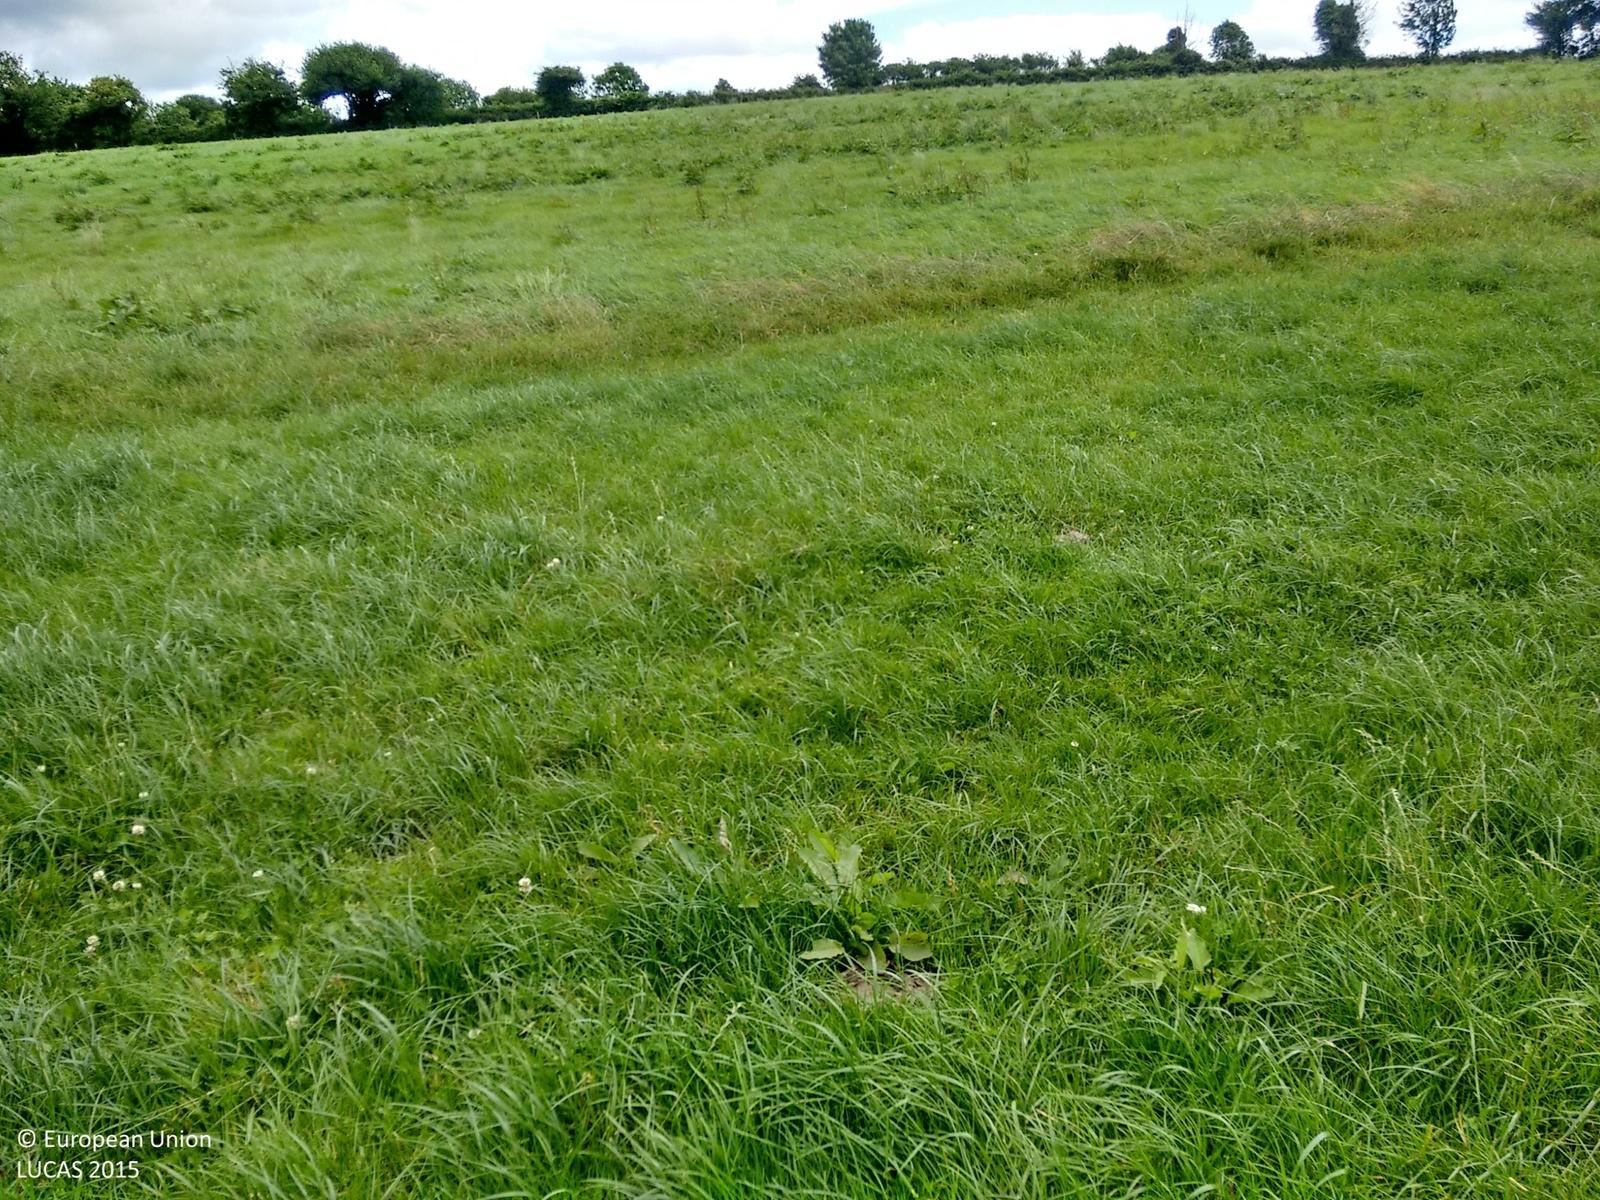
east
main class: Grassland
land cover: Grassland without tree/shrub cover
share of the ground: > 75 %
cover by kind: herbaceous plants 100 %
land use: Agriculture (excluding fallow land and kitchen gardens)
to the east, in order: Grassland without tree/shrub cover; Fences; Grassland without tree/shrub cover; Fences; Abandoned hedges; Fences; Grassland without tree/shrub cover; Fences; Abandoned hedges; Grassland without tree/shrub cover
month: July
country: IE
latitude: 52.1692
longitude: -8.2114
